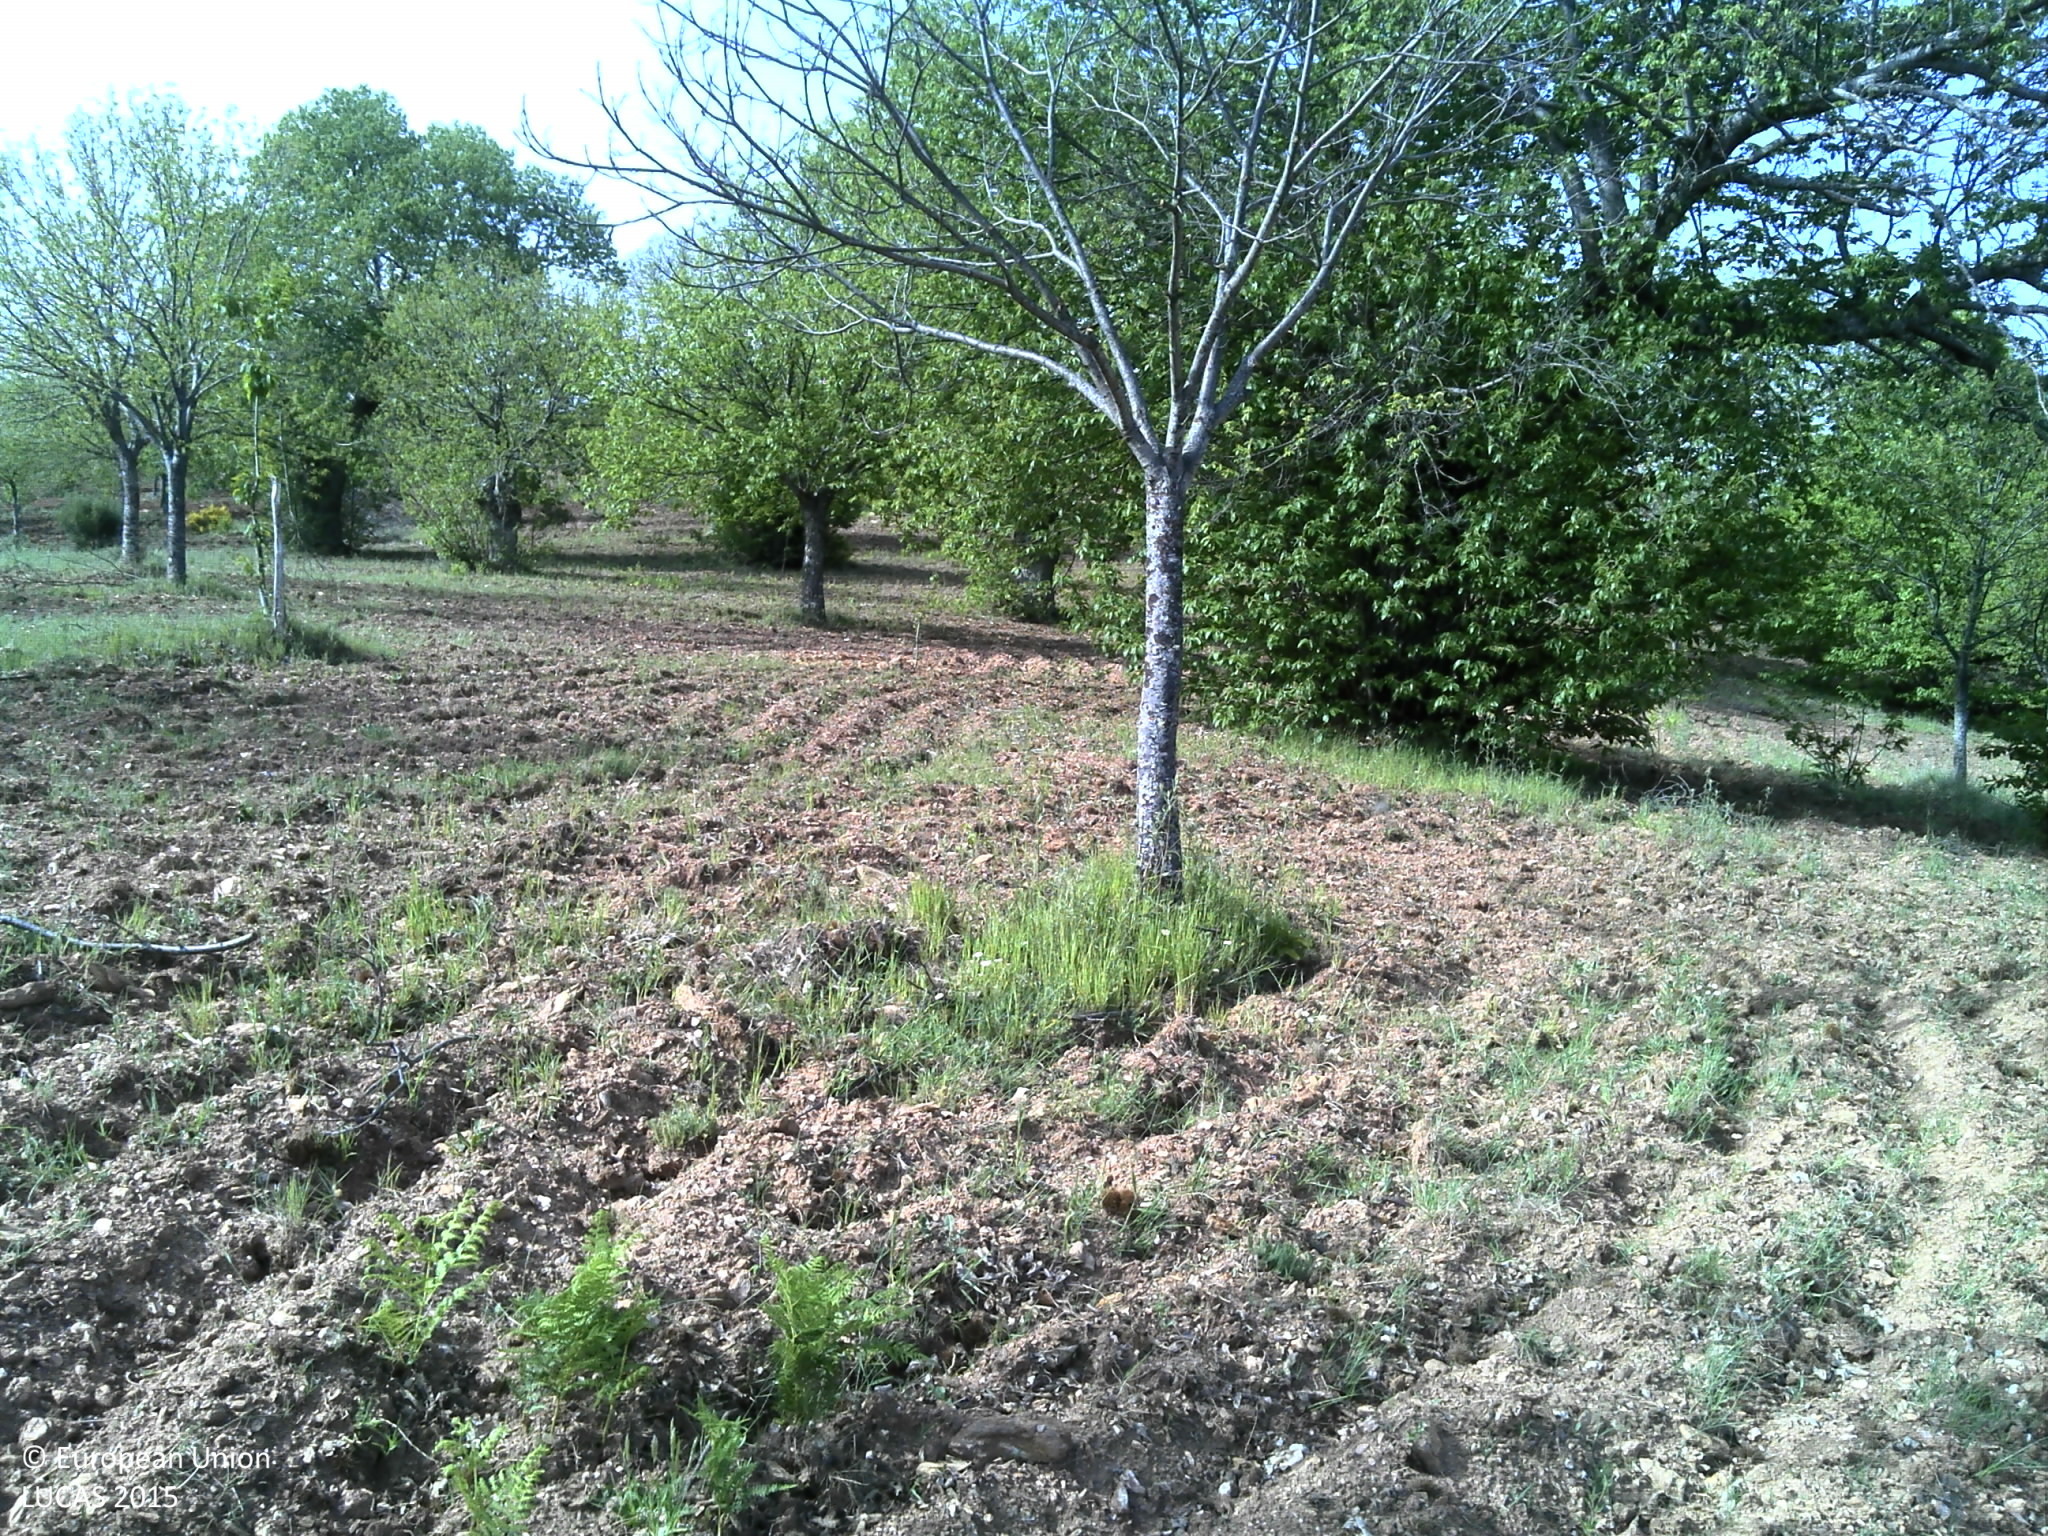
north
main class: Cropland
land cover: Nuts trees
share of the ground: 10 - 25 %
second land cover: Spontaneously vegetated surfaces
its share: 10 - 25 %
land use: Agriculture (excluding fallow land and kitchen gardens)
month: May
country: PT
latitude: 41.7096
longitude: -6.9542
